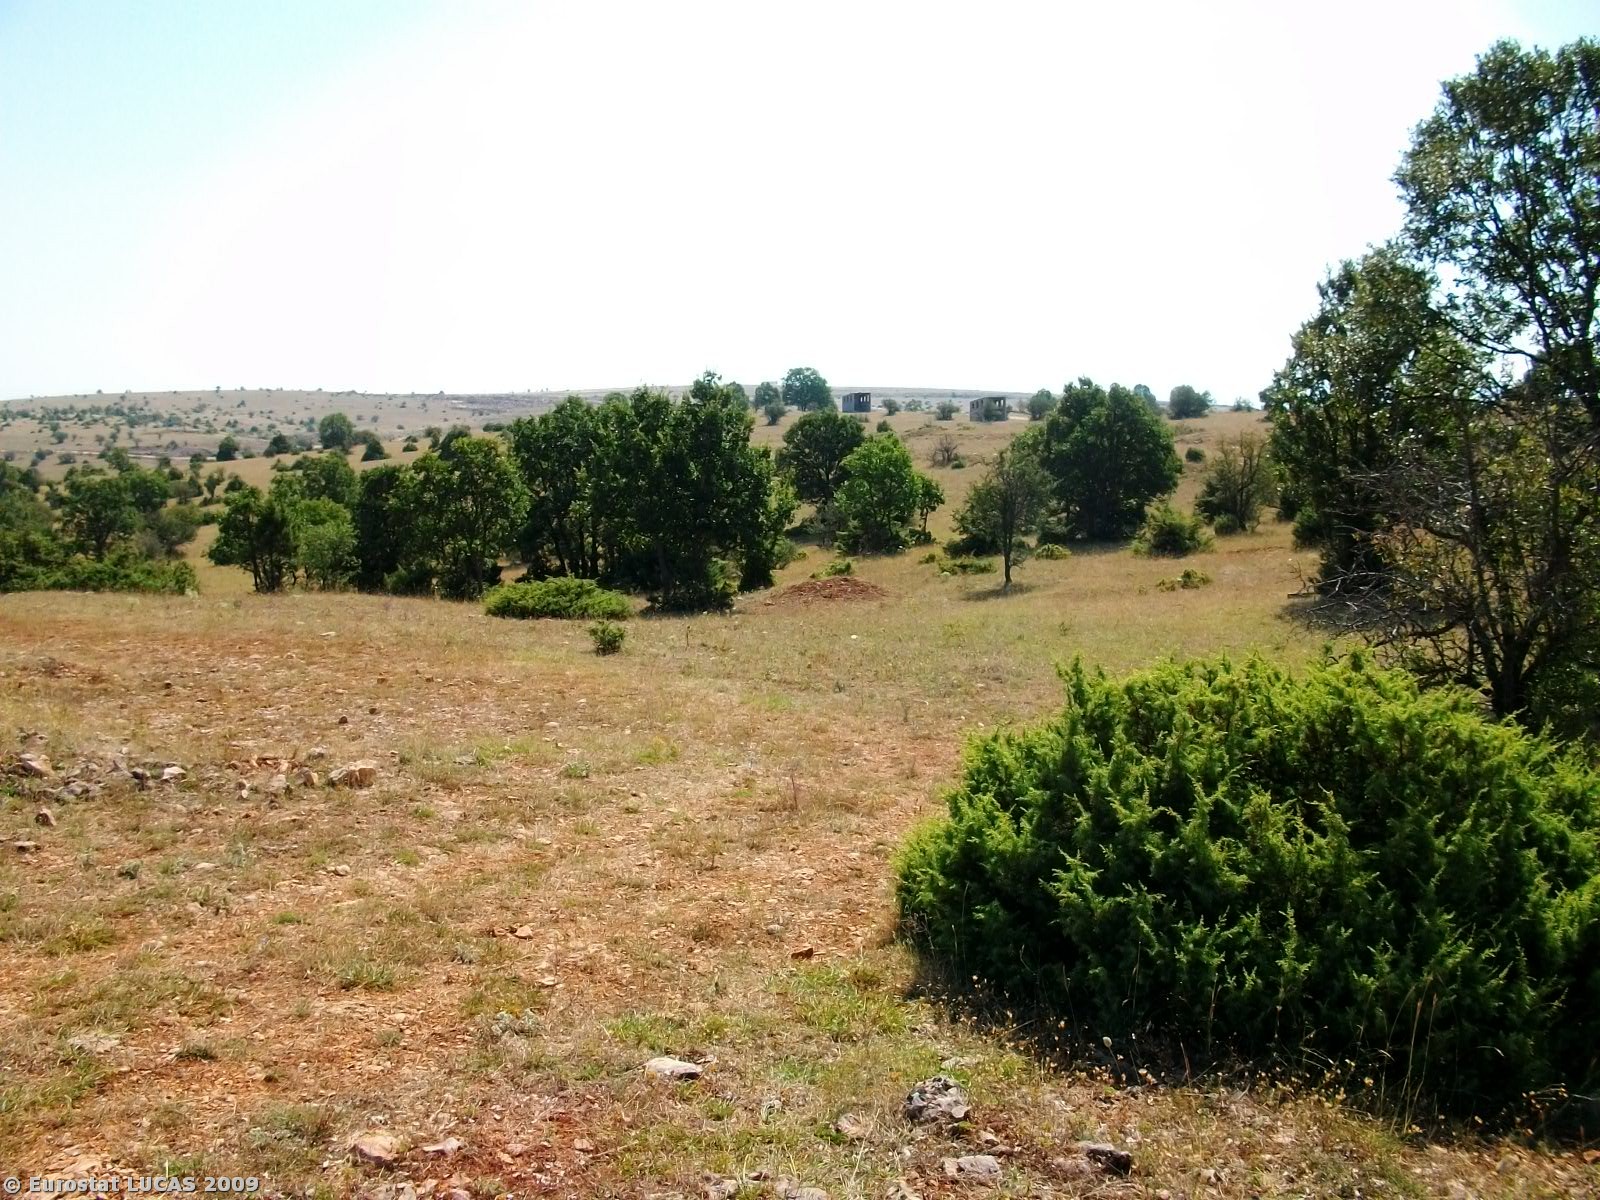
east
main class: Grassland
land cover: Grassland with sparse tree/shrub cover
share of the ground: > 75 %
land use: Agriculture (excluding fallow land and kitchen gardens)
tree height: > 5 m
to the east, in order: Grassland with sparse tree/shrub cover; Tracks; Grassland with sparse tree/shrub cover; Broadleaved woodland; Grassland with sparse tree/shrub cover; Grassland without tree/shrub cover; Grassland with sparse tree/shrub cover
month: July
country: GR
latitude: 40.2722
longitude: 21.7395
